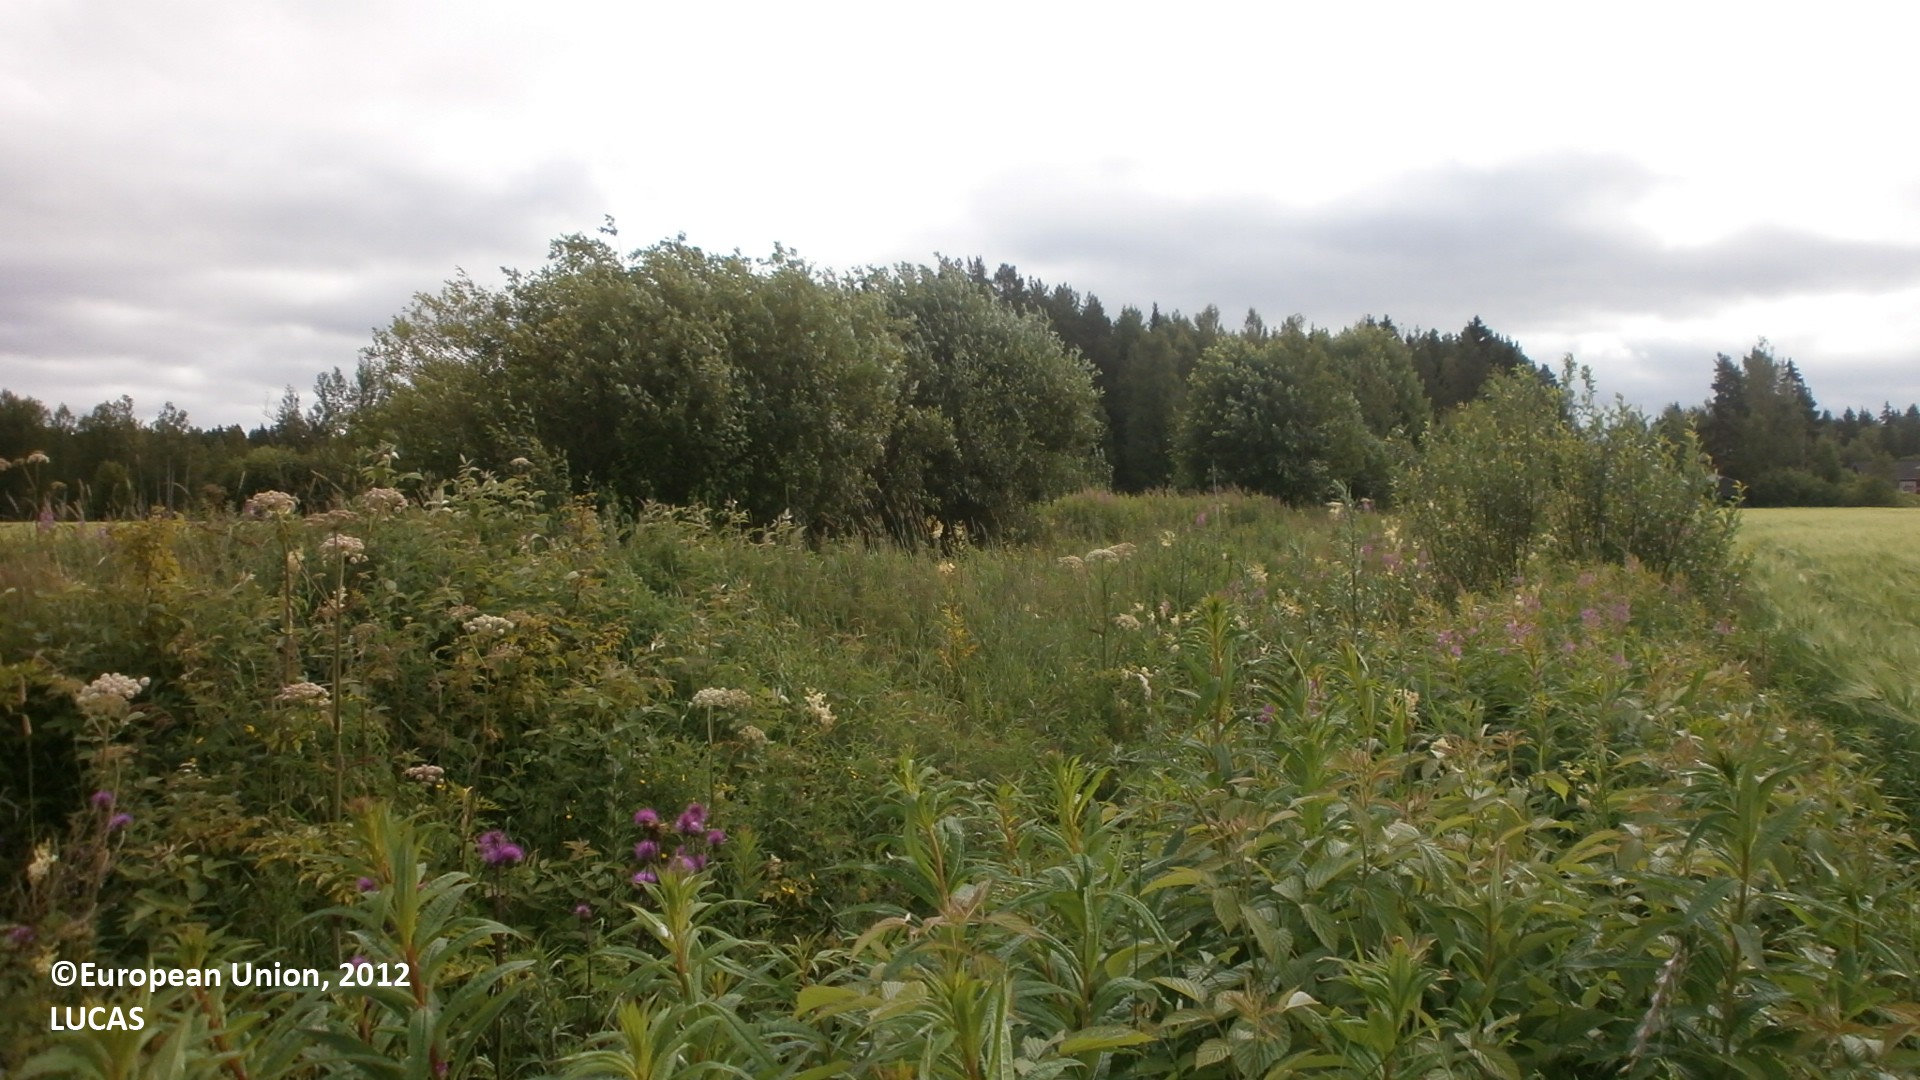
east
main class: Cropland
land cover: Barley
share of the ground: > 75 %
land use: Agriculture (excluding fallow land and kitchen gardens)
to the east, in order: Barley; Shruby margins; Ditches and canals; Shruby margins; Tracks; Lines of trees; Ditches and canals; Shruby margins; Temporary grasslands; Shruby margins; Ditches and canals; Spruce dominated coniferous woodland; Shruby margins; Ditches and canals; Shruby margins; Barley; Grassland without tree/shrub cover; Lines of trees; Inland running water; Abandoned hedges; Grassland without tree/shrub cover; Broadleaved woodland; Grassland without tree/shrub cover
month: July
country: FI
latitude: 63.9993
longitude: 23.7388
